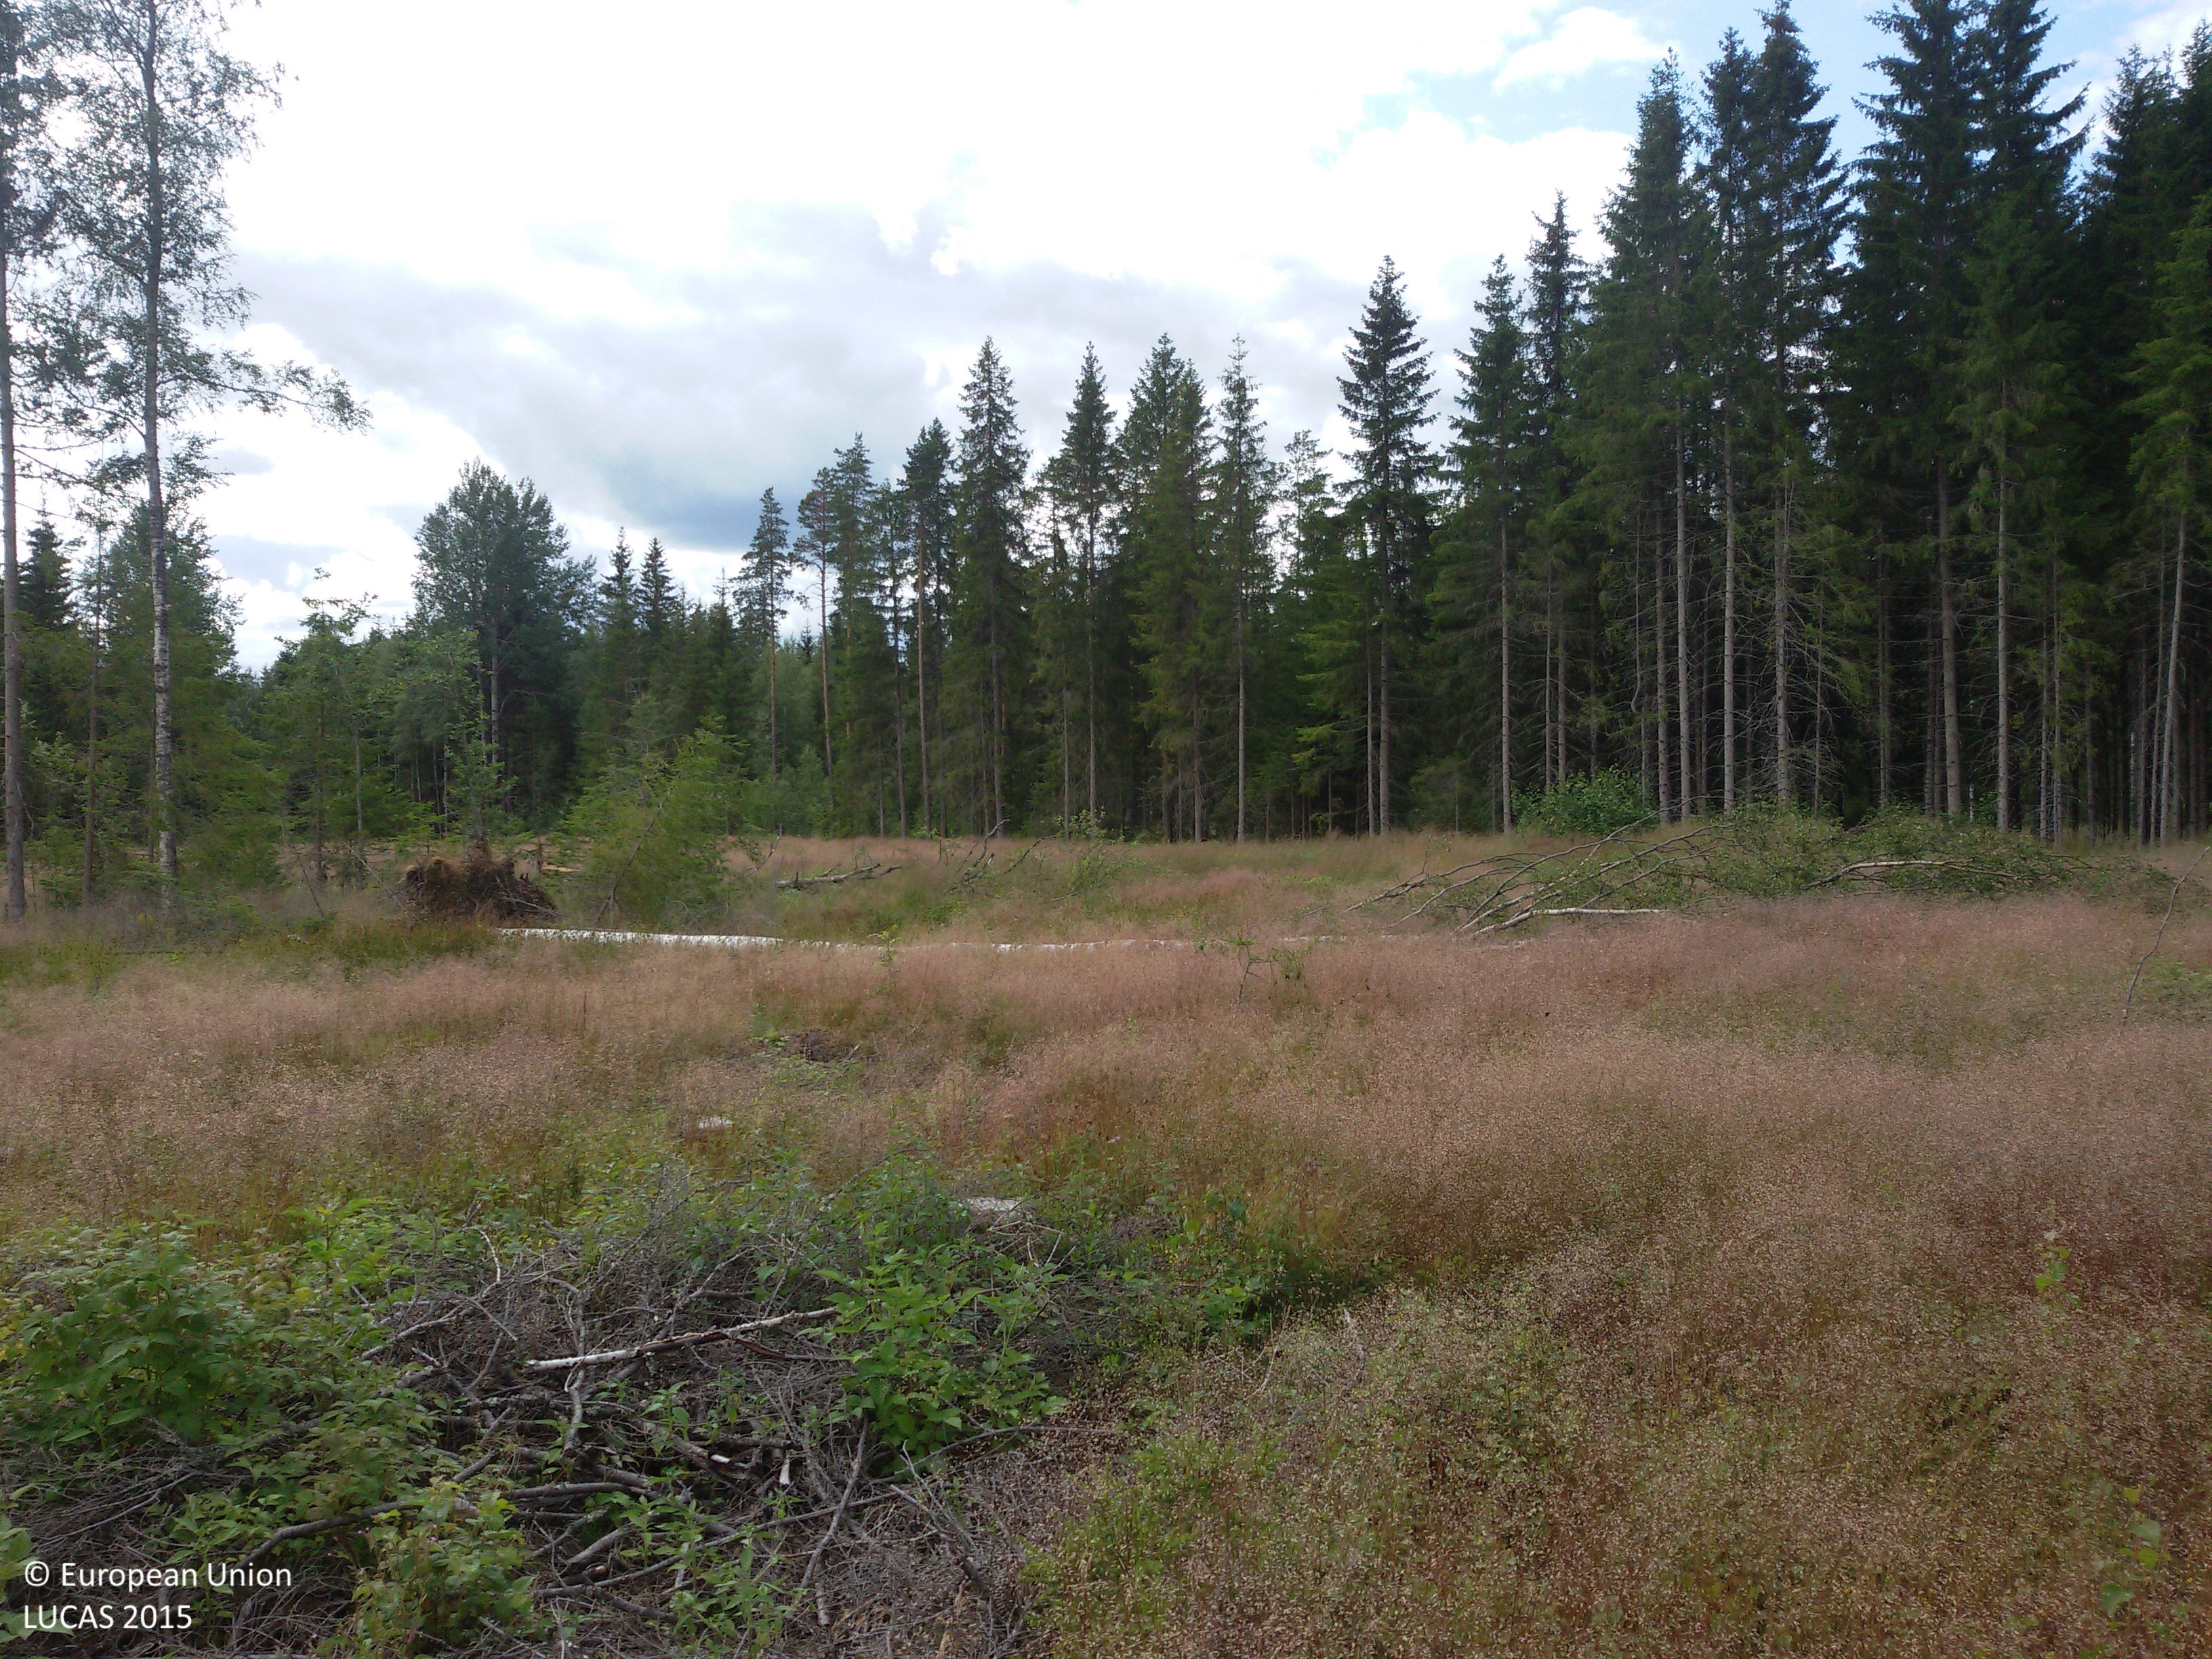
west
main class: Woodland
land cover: Spruce dominated mixed woodland
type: boreal forest
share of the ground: 25 - 50 %
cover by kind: herbaceous plants 50 %, broadleaved forest trees 30 %, coniferous forest trees 20 %
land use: Forestry
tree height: < 5 m
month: July
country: SE
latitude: 60.4389
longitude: 15.3848
